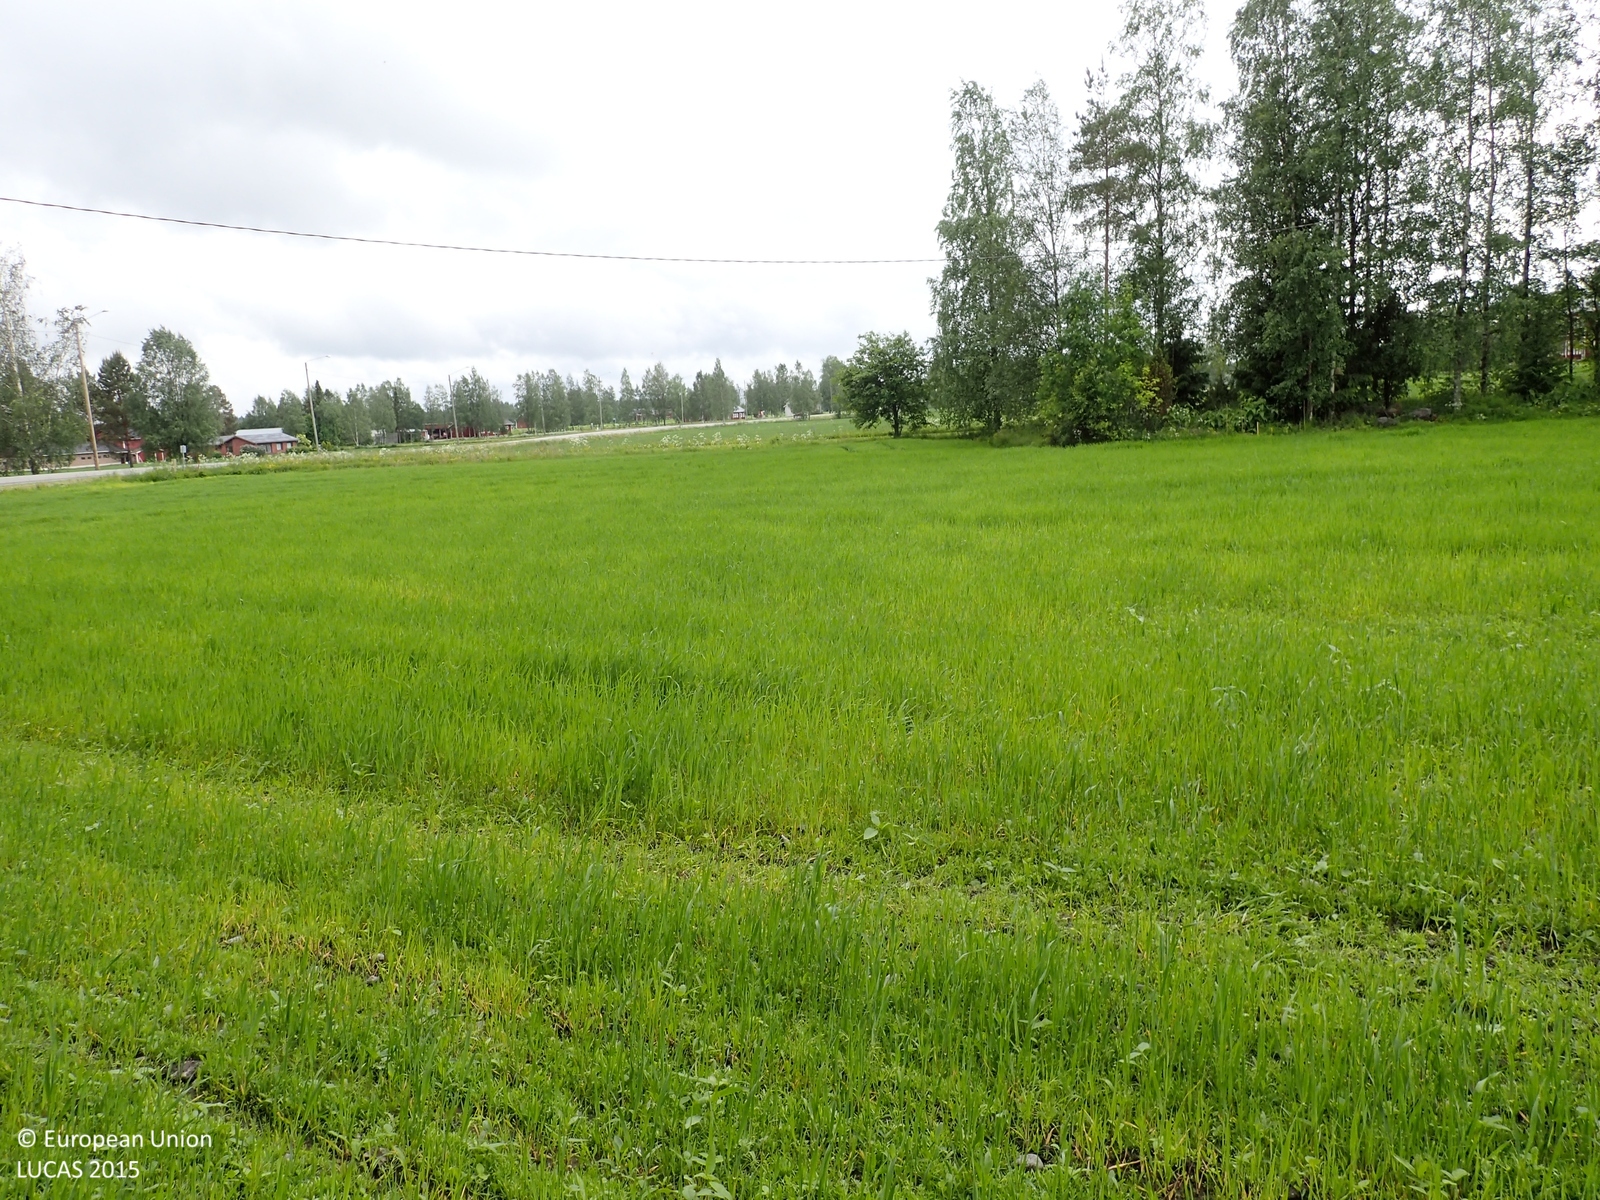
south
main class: Cropland
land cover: Barley
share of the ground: > 75 %
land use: Agriculture (excluding fallow land and kitchen gardens)
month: June
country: FI
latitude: 62.3174
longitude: 21.7205
